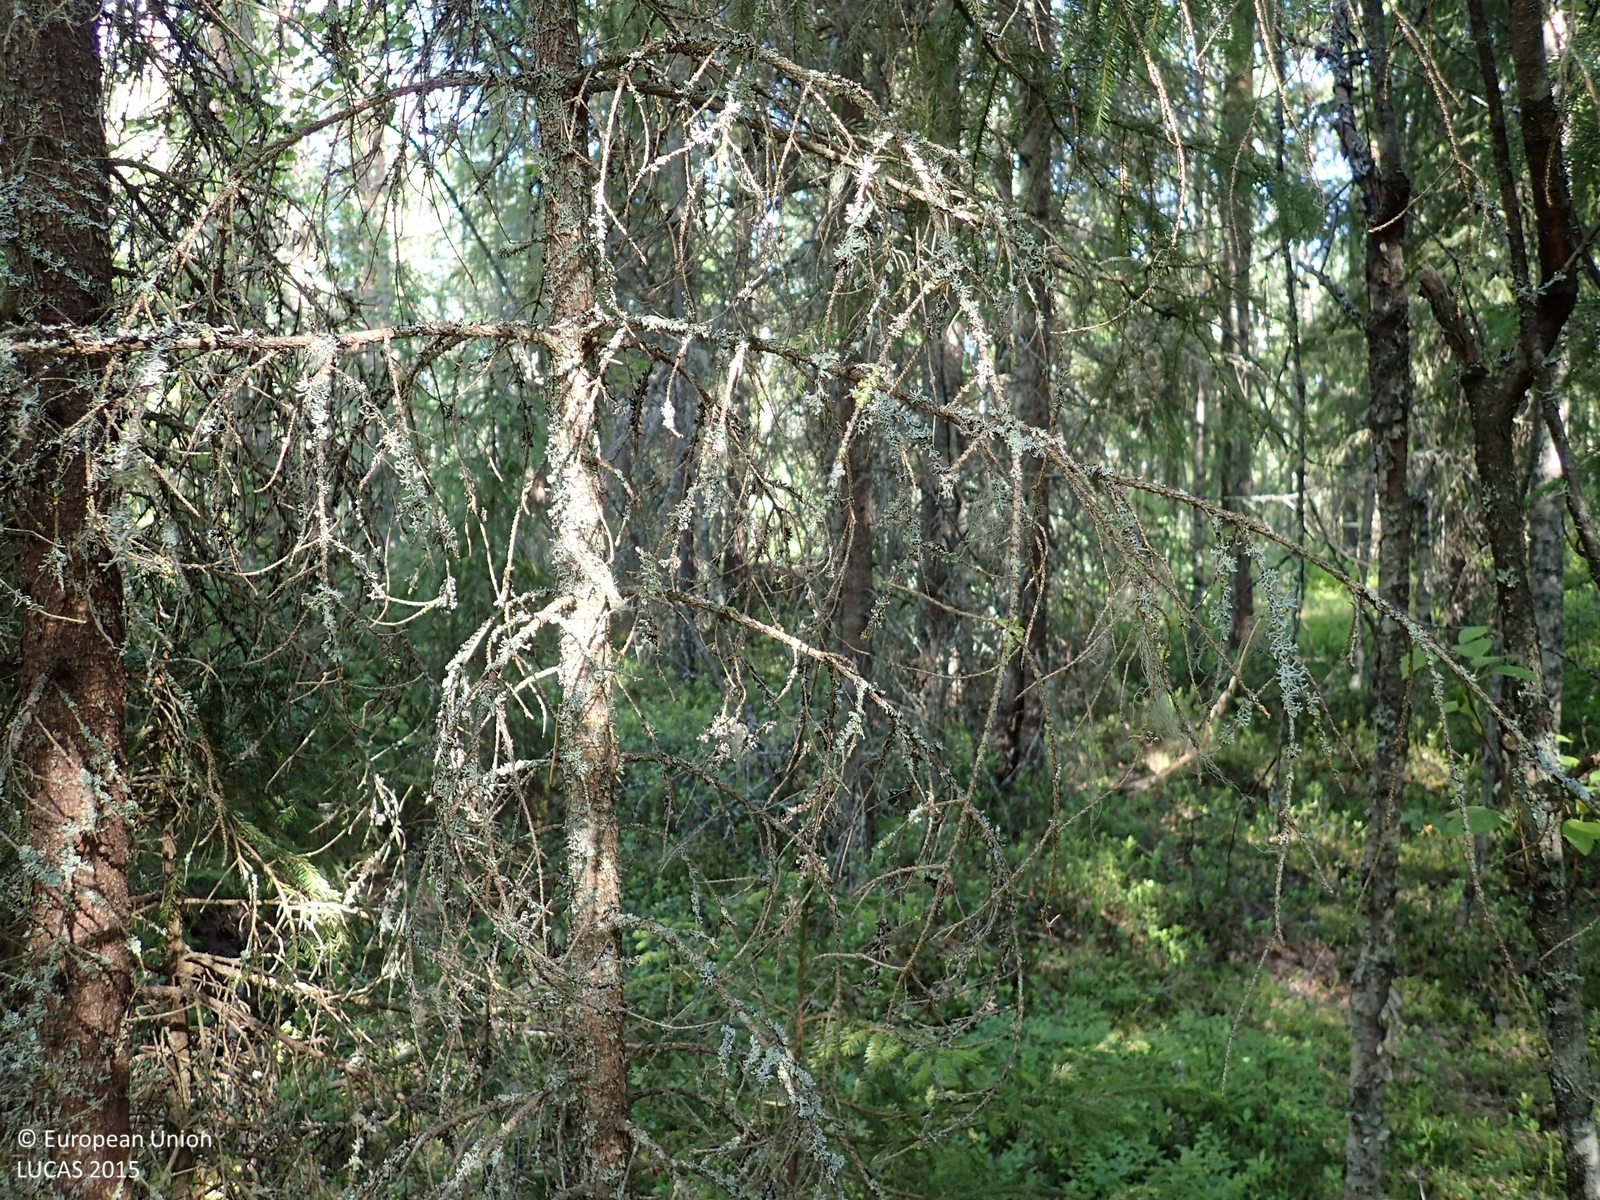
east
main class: Woodland
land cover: Other mixed woodland
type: boreal forest
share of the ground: > 75 %
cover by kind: coniferous forest trees 65 %, broadleaved forest trees 25 %, shrubs 5 %, lichens and mosses 5 %
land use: Forestry
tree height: > 5 m
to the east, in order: Other mixed woodland; Pine dominated mixed woodland; Pine dominated coniferous woodland
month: July
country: FI
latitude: 62.7636
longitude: 21.3801
